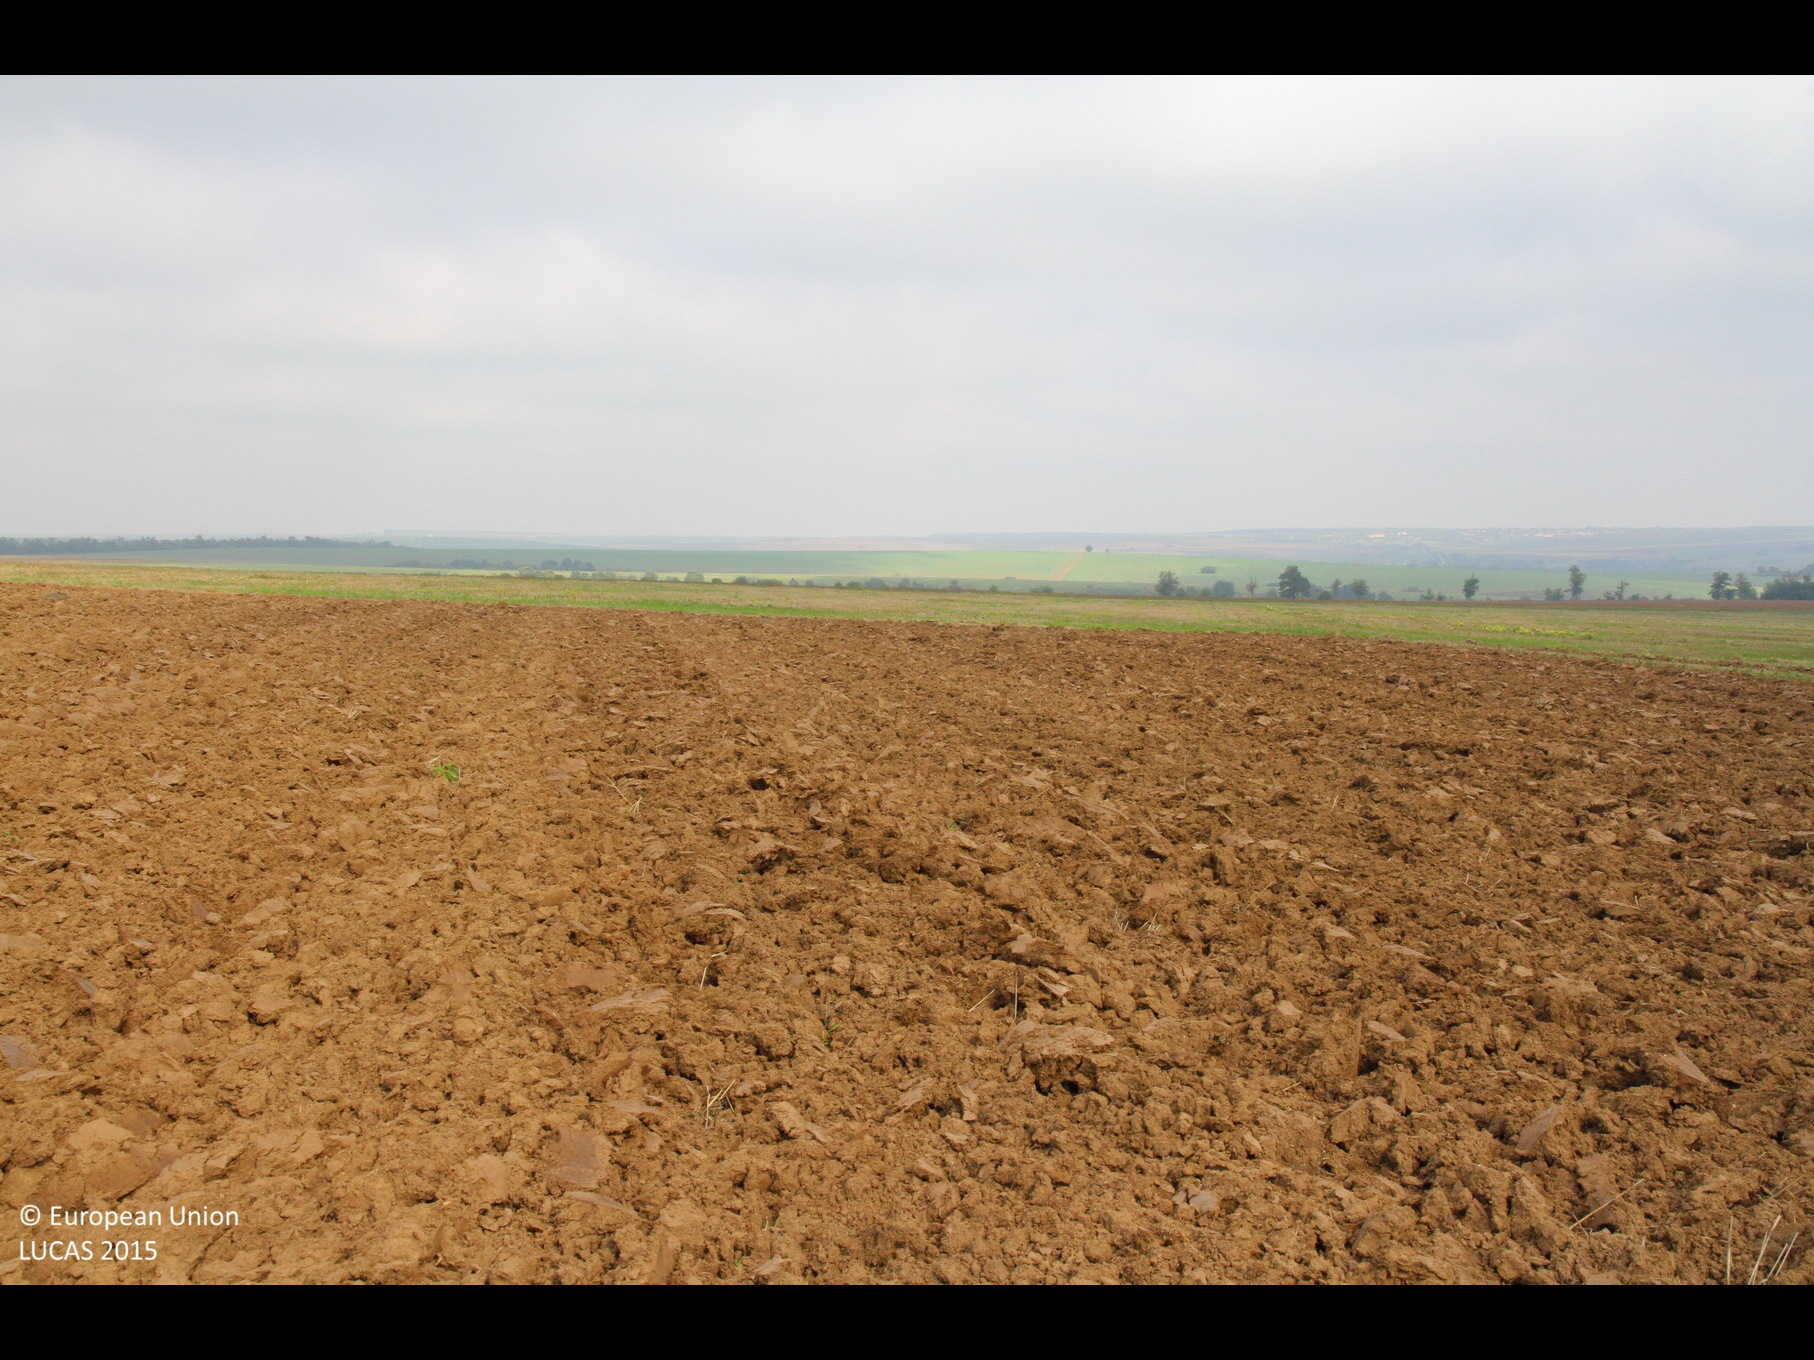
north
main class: Cropland
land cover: Common wheat
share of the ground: < 10 %
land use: Agriculture (excluding fallow land and kitchen gardens)
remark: Harvested field
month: October
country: BG
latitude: 43.5366
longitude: 27.0353
